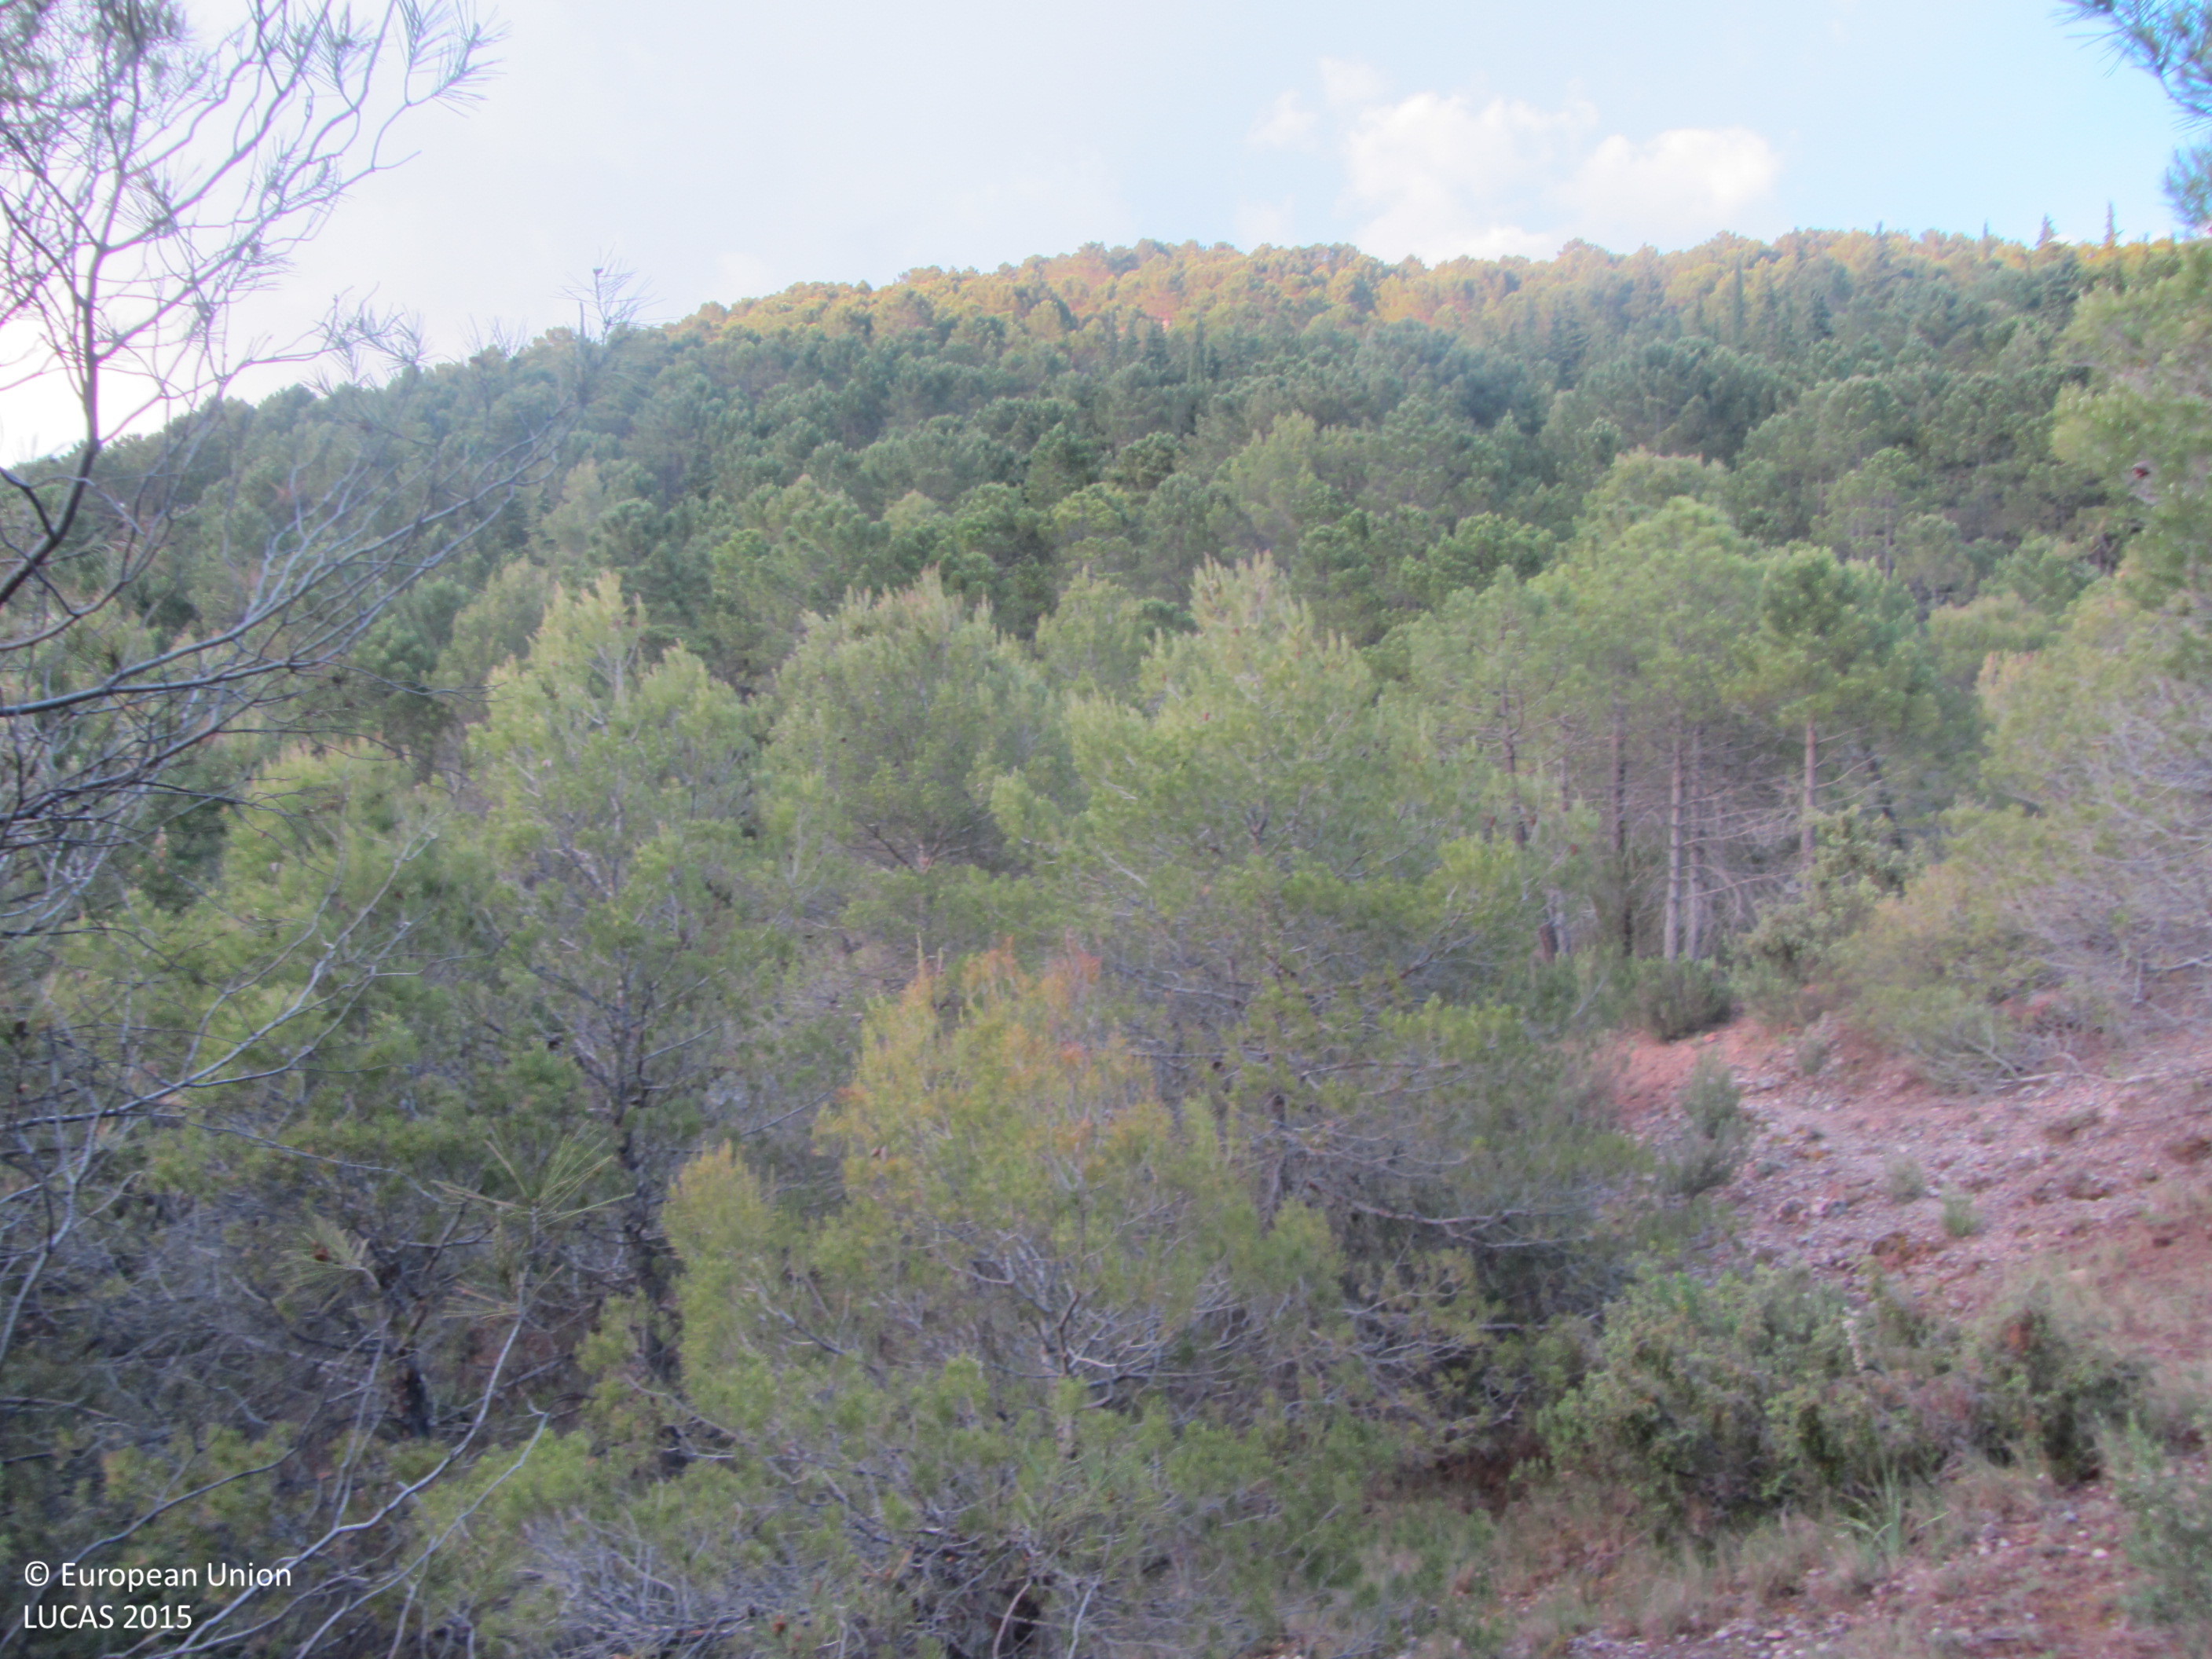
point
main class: Woodland
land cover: Pine dominated coniferous woodland
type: coniferous forest of the mediterranean region
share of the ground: > 75 %
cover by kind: coniferous forest trees 90 %, shrubs 5 %, consolidated bare surface 5 %
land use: Forestry
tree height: > 5 m
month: May
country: ES
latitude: 38.1330
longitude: -2.8775
